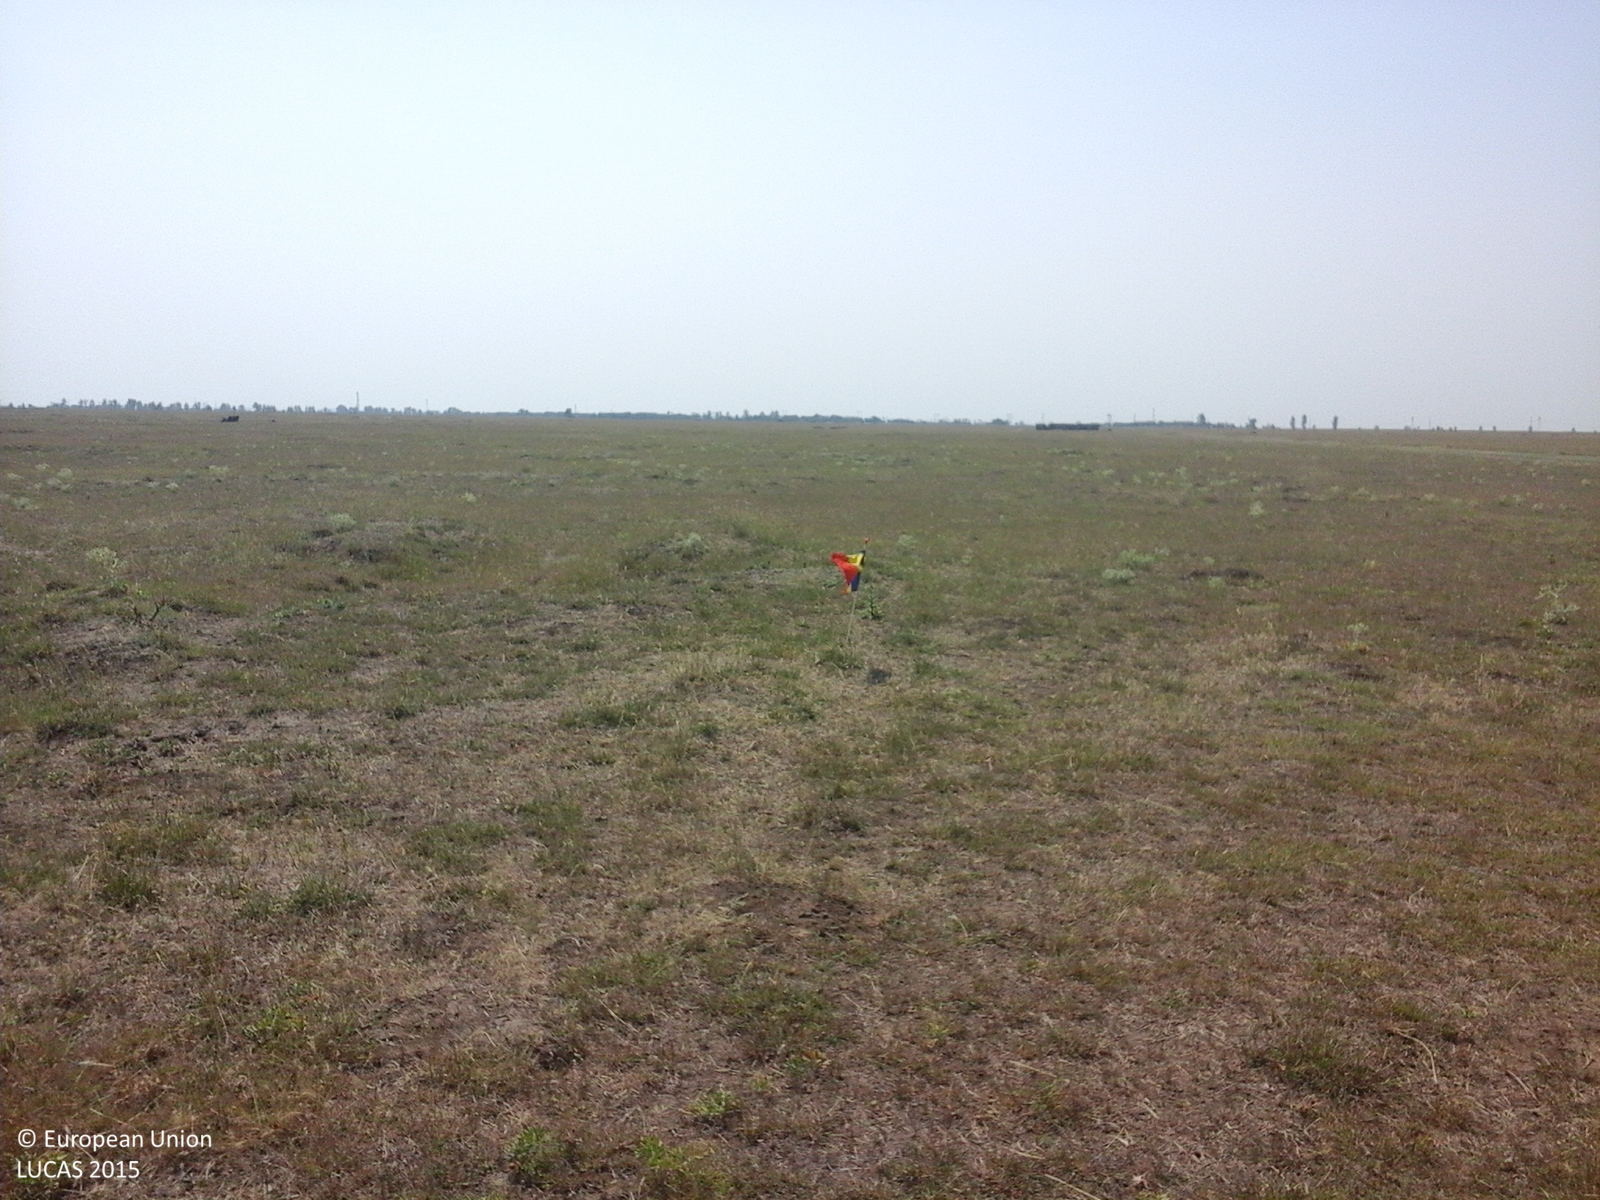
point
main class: Grassland
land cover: Grassland without tree/shrub cover
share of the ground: > 75 %
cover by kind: herbaceous plants 85 %, consolidated bare surface 15 %
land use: Agriculture (excluding fallow land and kitchen gardens)
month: July
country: RO
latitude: 45.5433
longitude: 27.9047
